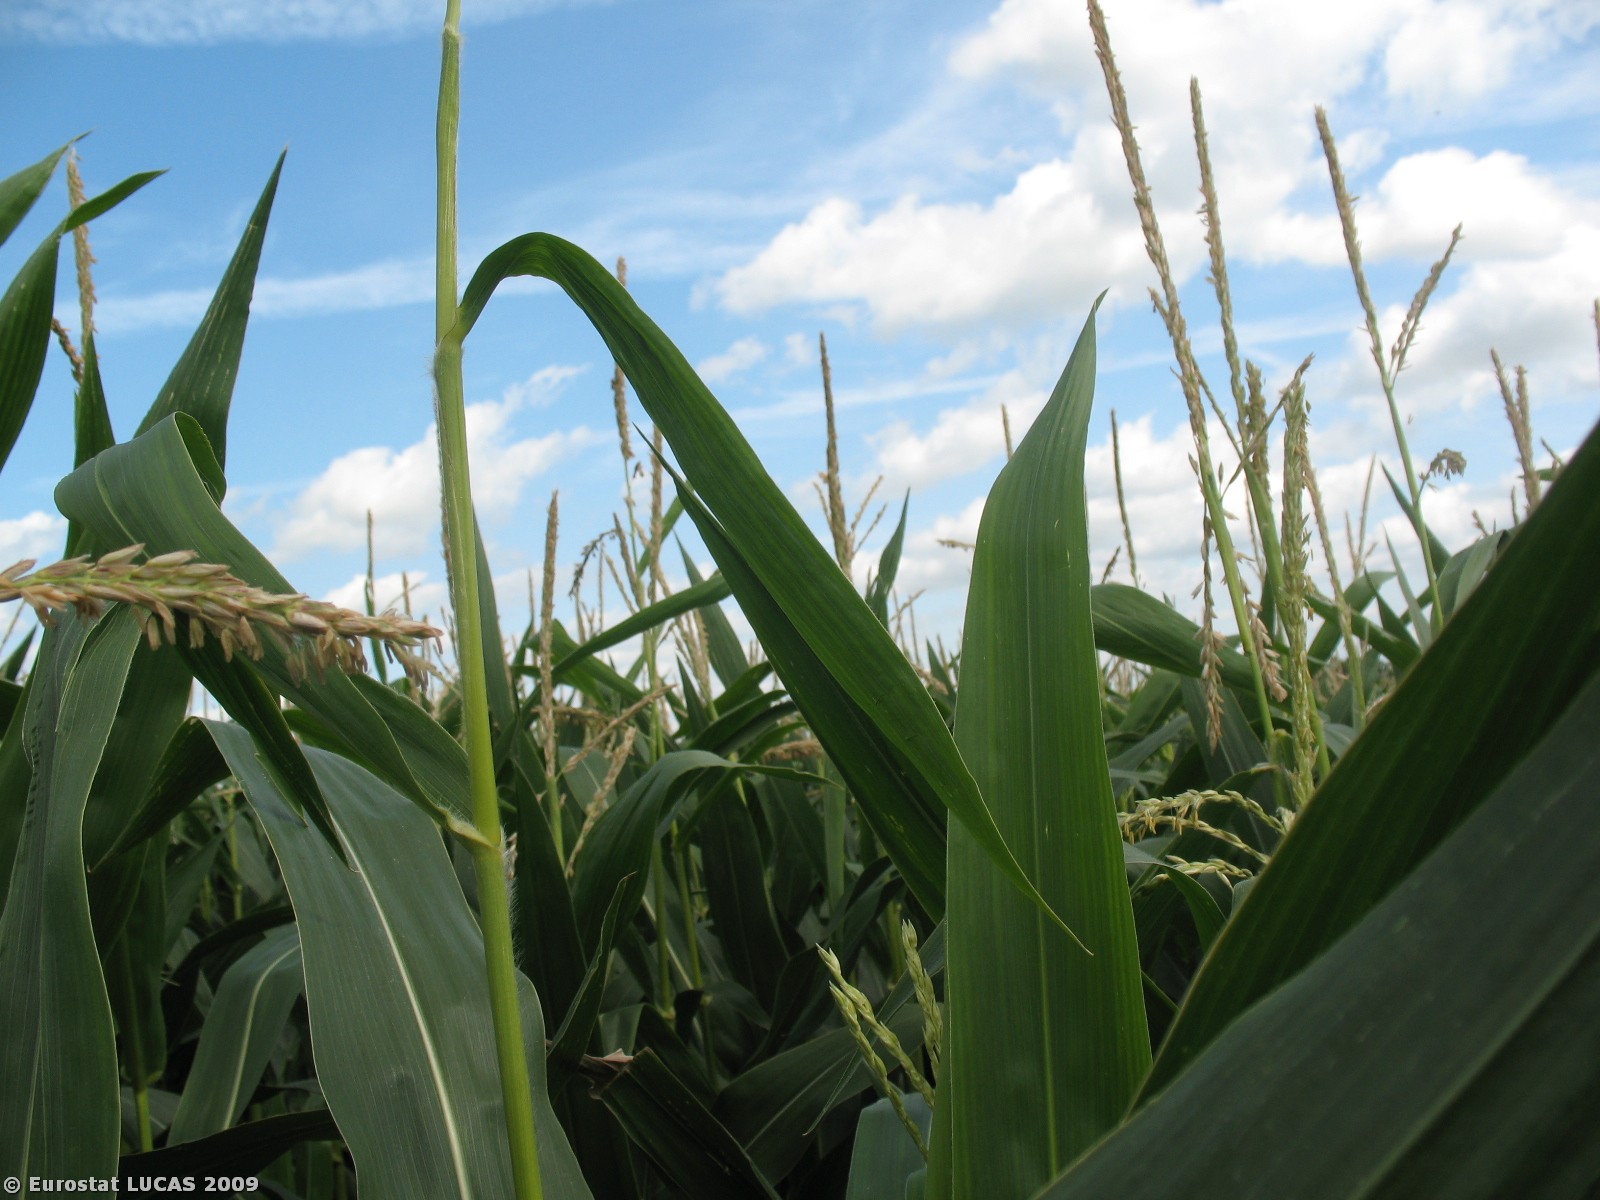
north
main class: Cropland
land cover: Maize
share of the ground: > 75 %
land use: Agriculture (excluding fallow land and kitchen gardens)
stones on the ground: < 10 %
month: July
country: BE
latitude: 50.8592
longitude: 3.7280
